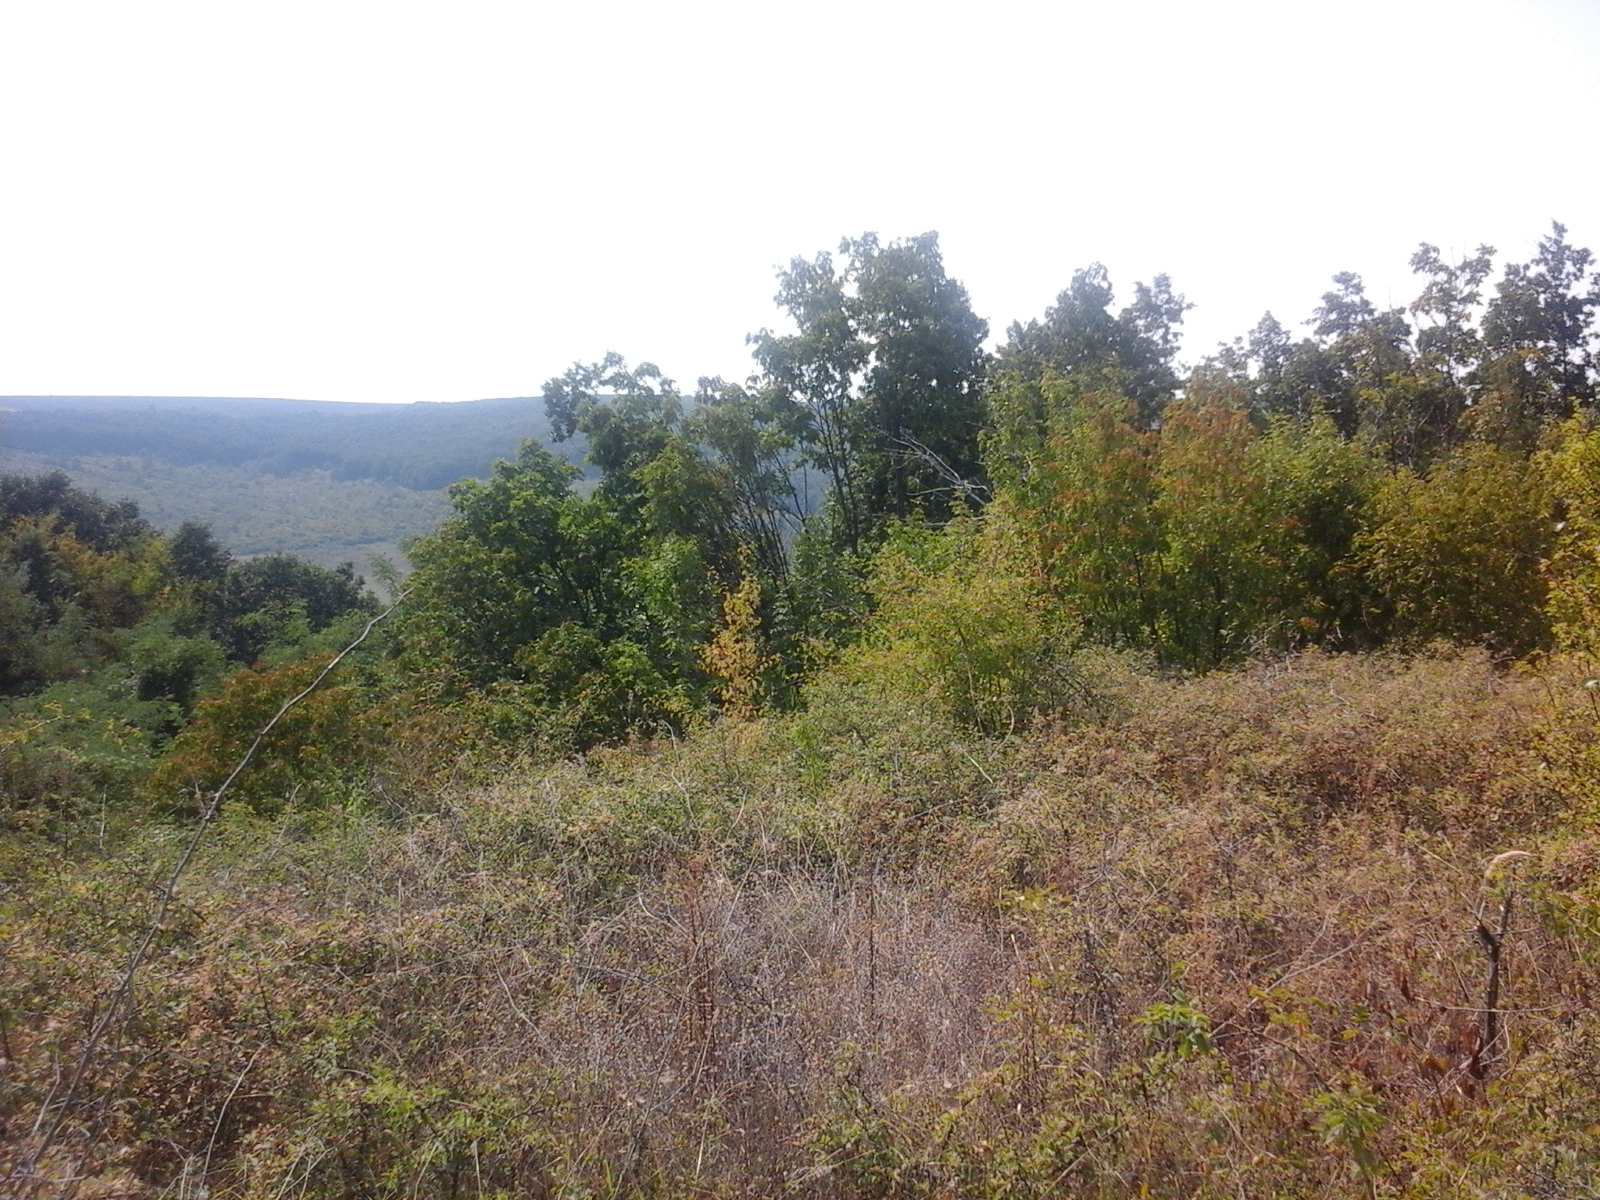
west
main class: Shrubland
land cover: Shrubland with sparse tree cover
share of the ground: > 75 %
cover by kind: shrubs 95 %, broadleaved forest trees 5 %
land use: Semi-natural and natural areas not in use
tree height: < 5 m
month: August
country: RO
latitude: 44.4788
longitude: 23.6975
